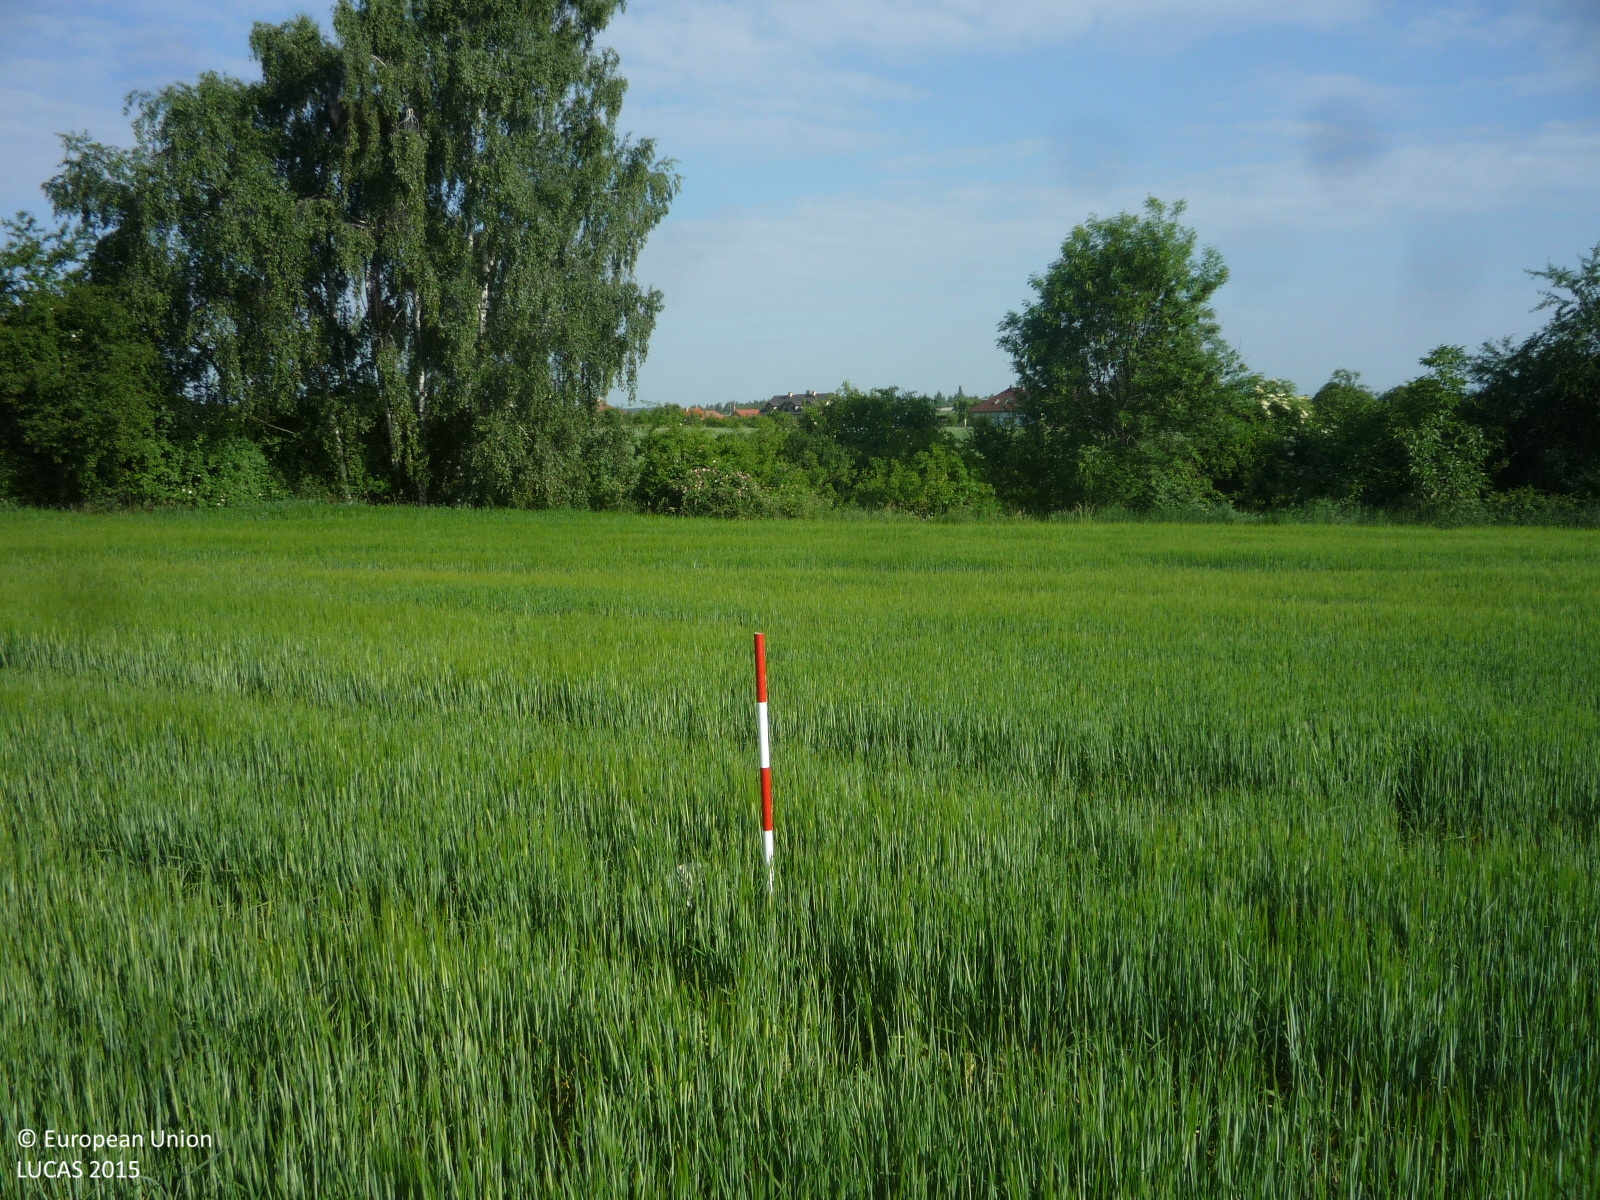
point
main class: Cropland
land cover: Barley
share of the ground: > 75 %
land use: Agriculture (excluding fallow land and kitchen gardens)
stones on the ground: < 10 %
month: June
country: CZ
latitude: 50.2024
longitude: 14.0500
